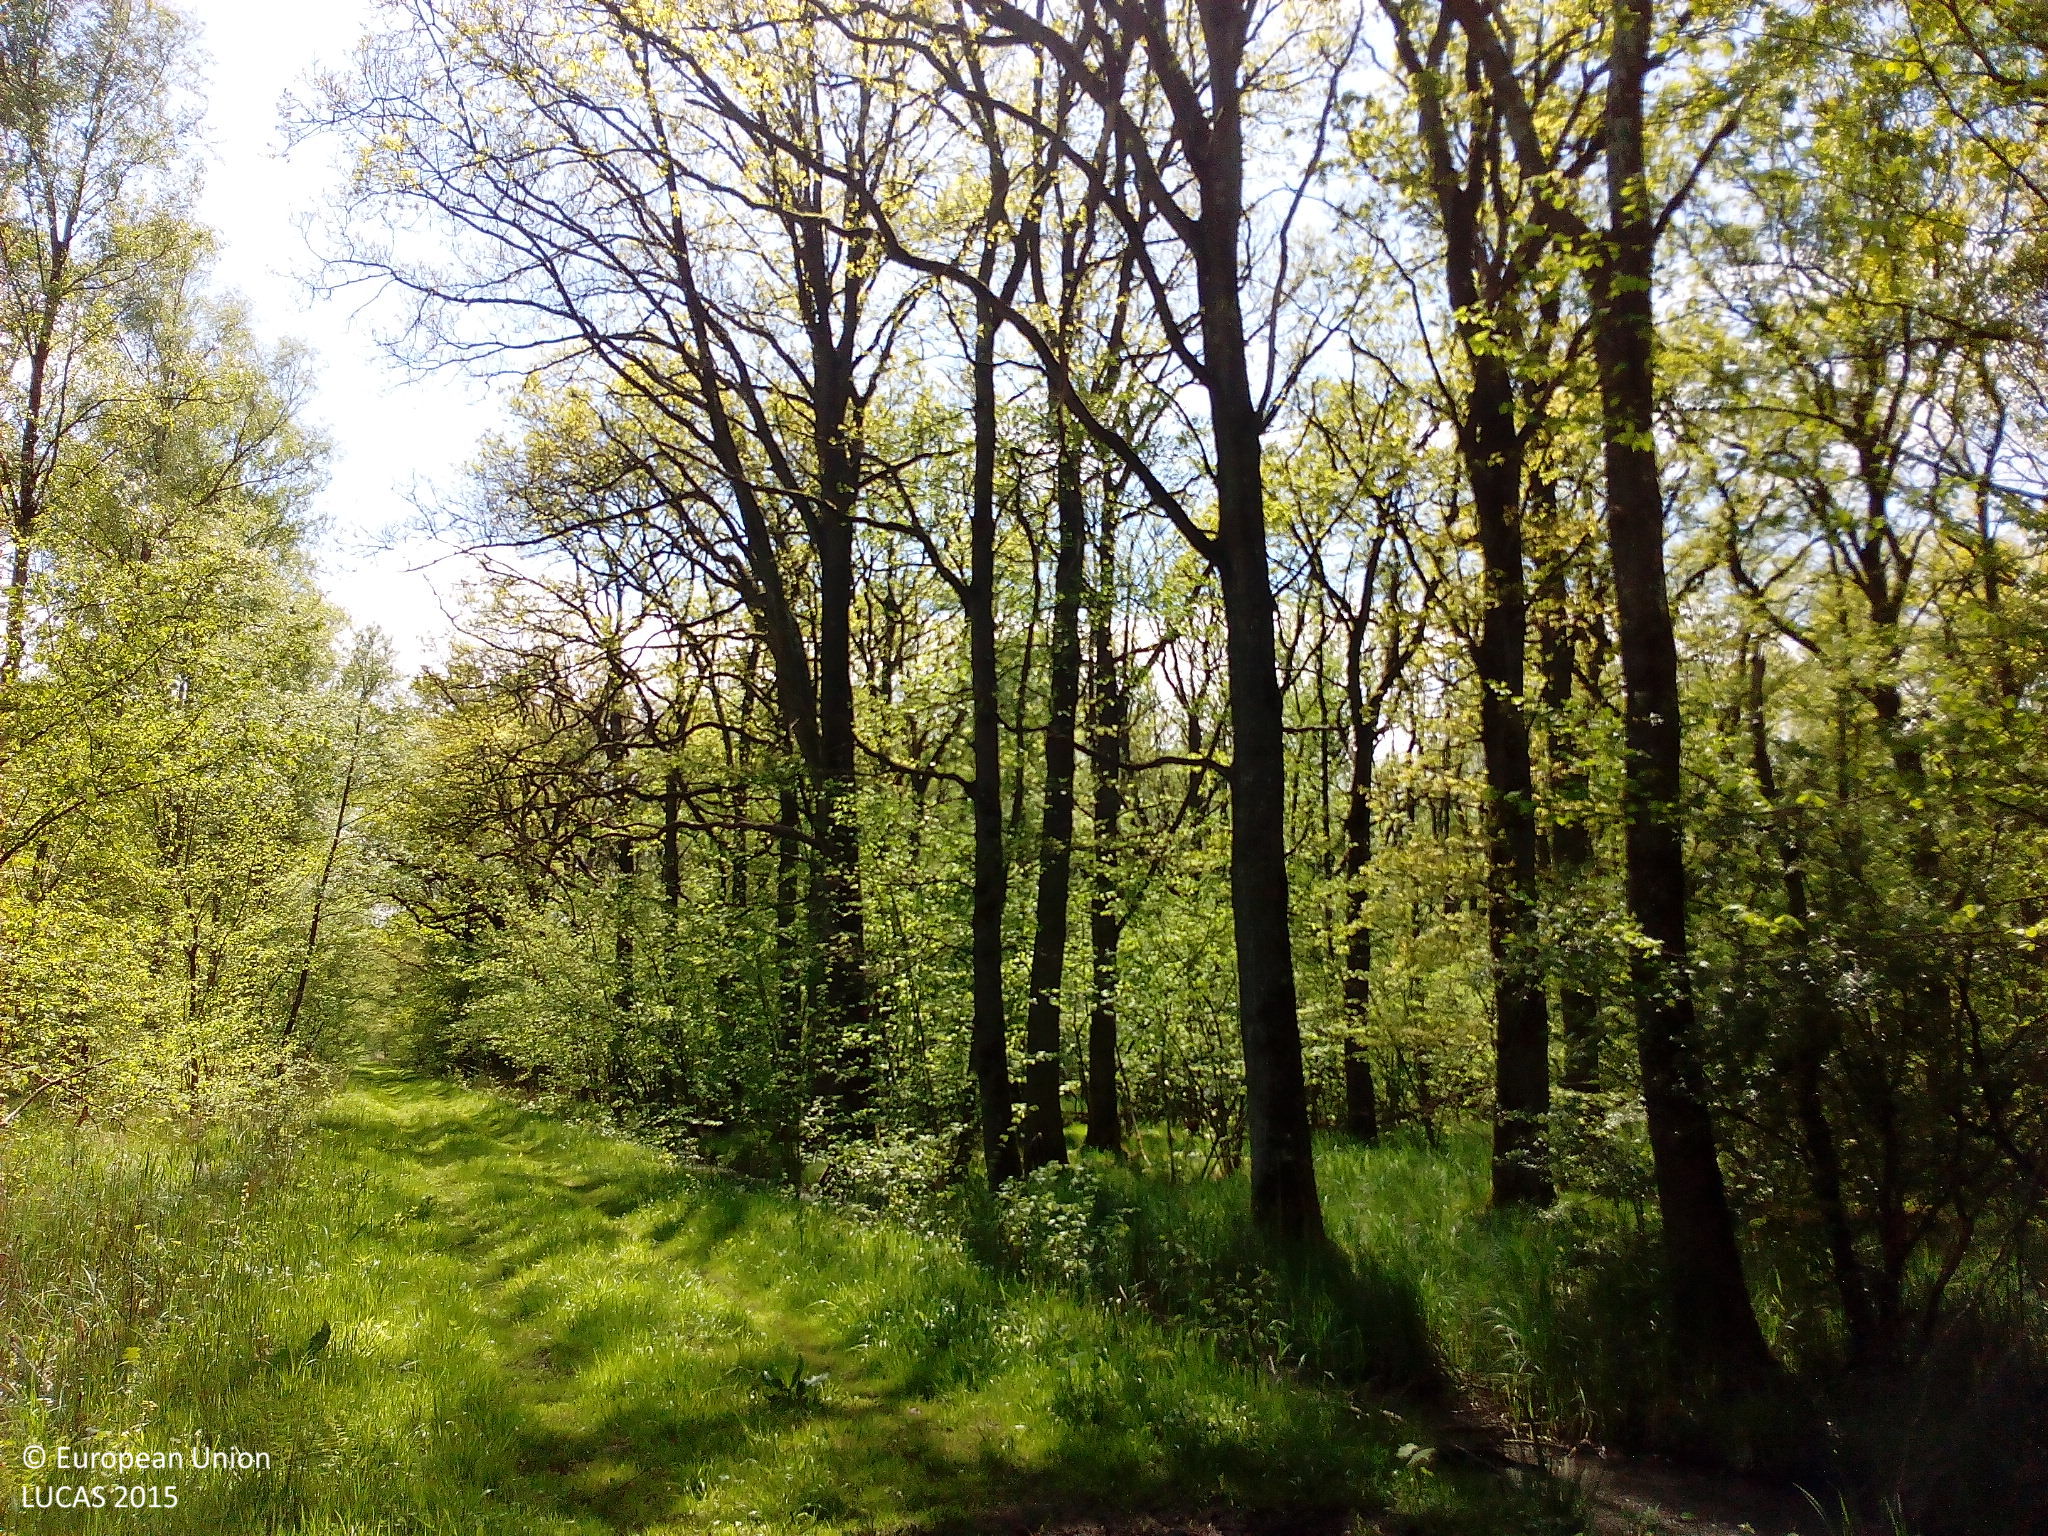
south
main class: Woodland
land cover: Broadleaved woodland
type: mesophytic deciduous forest
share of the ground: > 75 %
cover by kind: broadleaved forest trees 90 %, shrubs 5 %, herbaceous plants 5 %
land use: Forestry
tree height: > 5 m
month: May
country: DE
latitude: 54.3438
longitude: 12.6602
